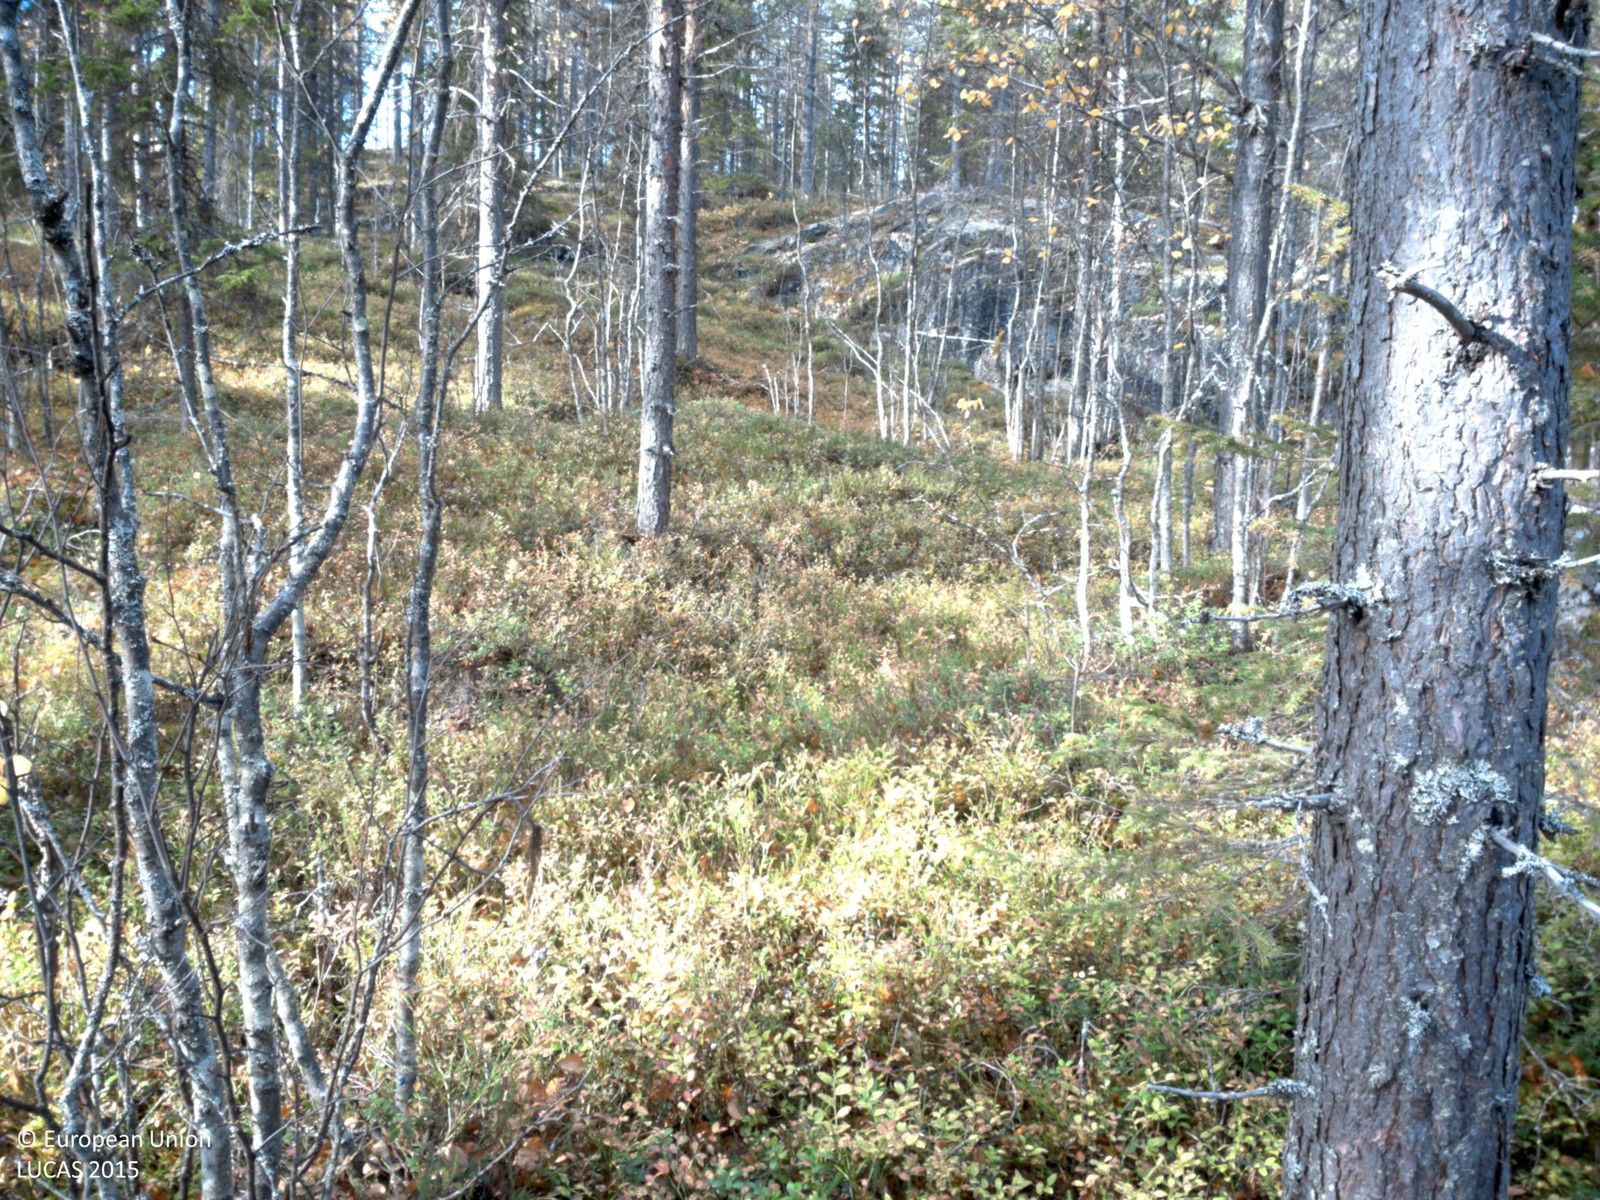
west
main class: Woodland
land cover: Pine dominated mixed woodland
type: boreal forest
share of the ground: > 75 %
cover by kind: coniferous forest trees 60 %, broadleaved forest trees 20 %, shrubs 10 %, consolidated bare surface 10 %
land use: Forestry
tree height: > 5 m
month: October
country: SE
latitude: 64.8166
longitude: 17.9477
